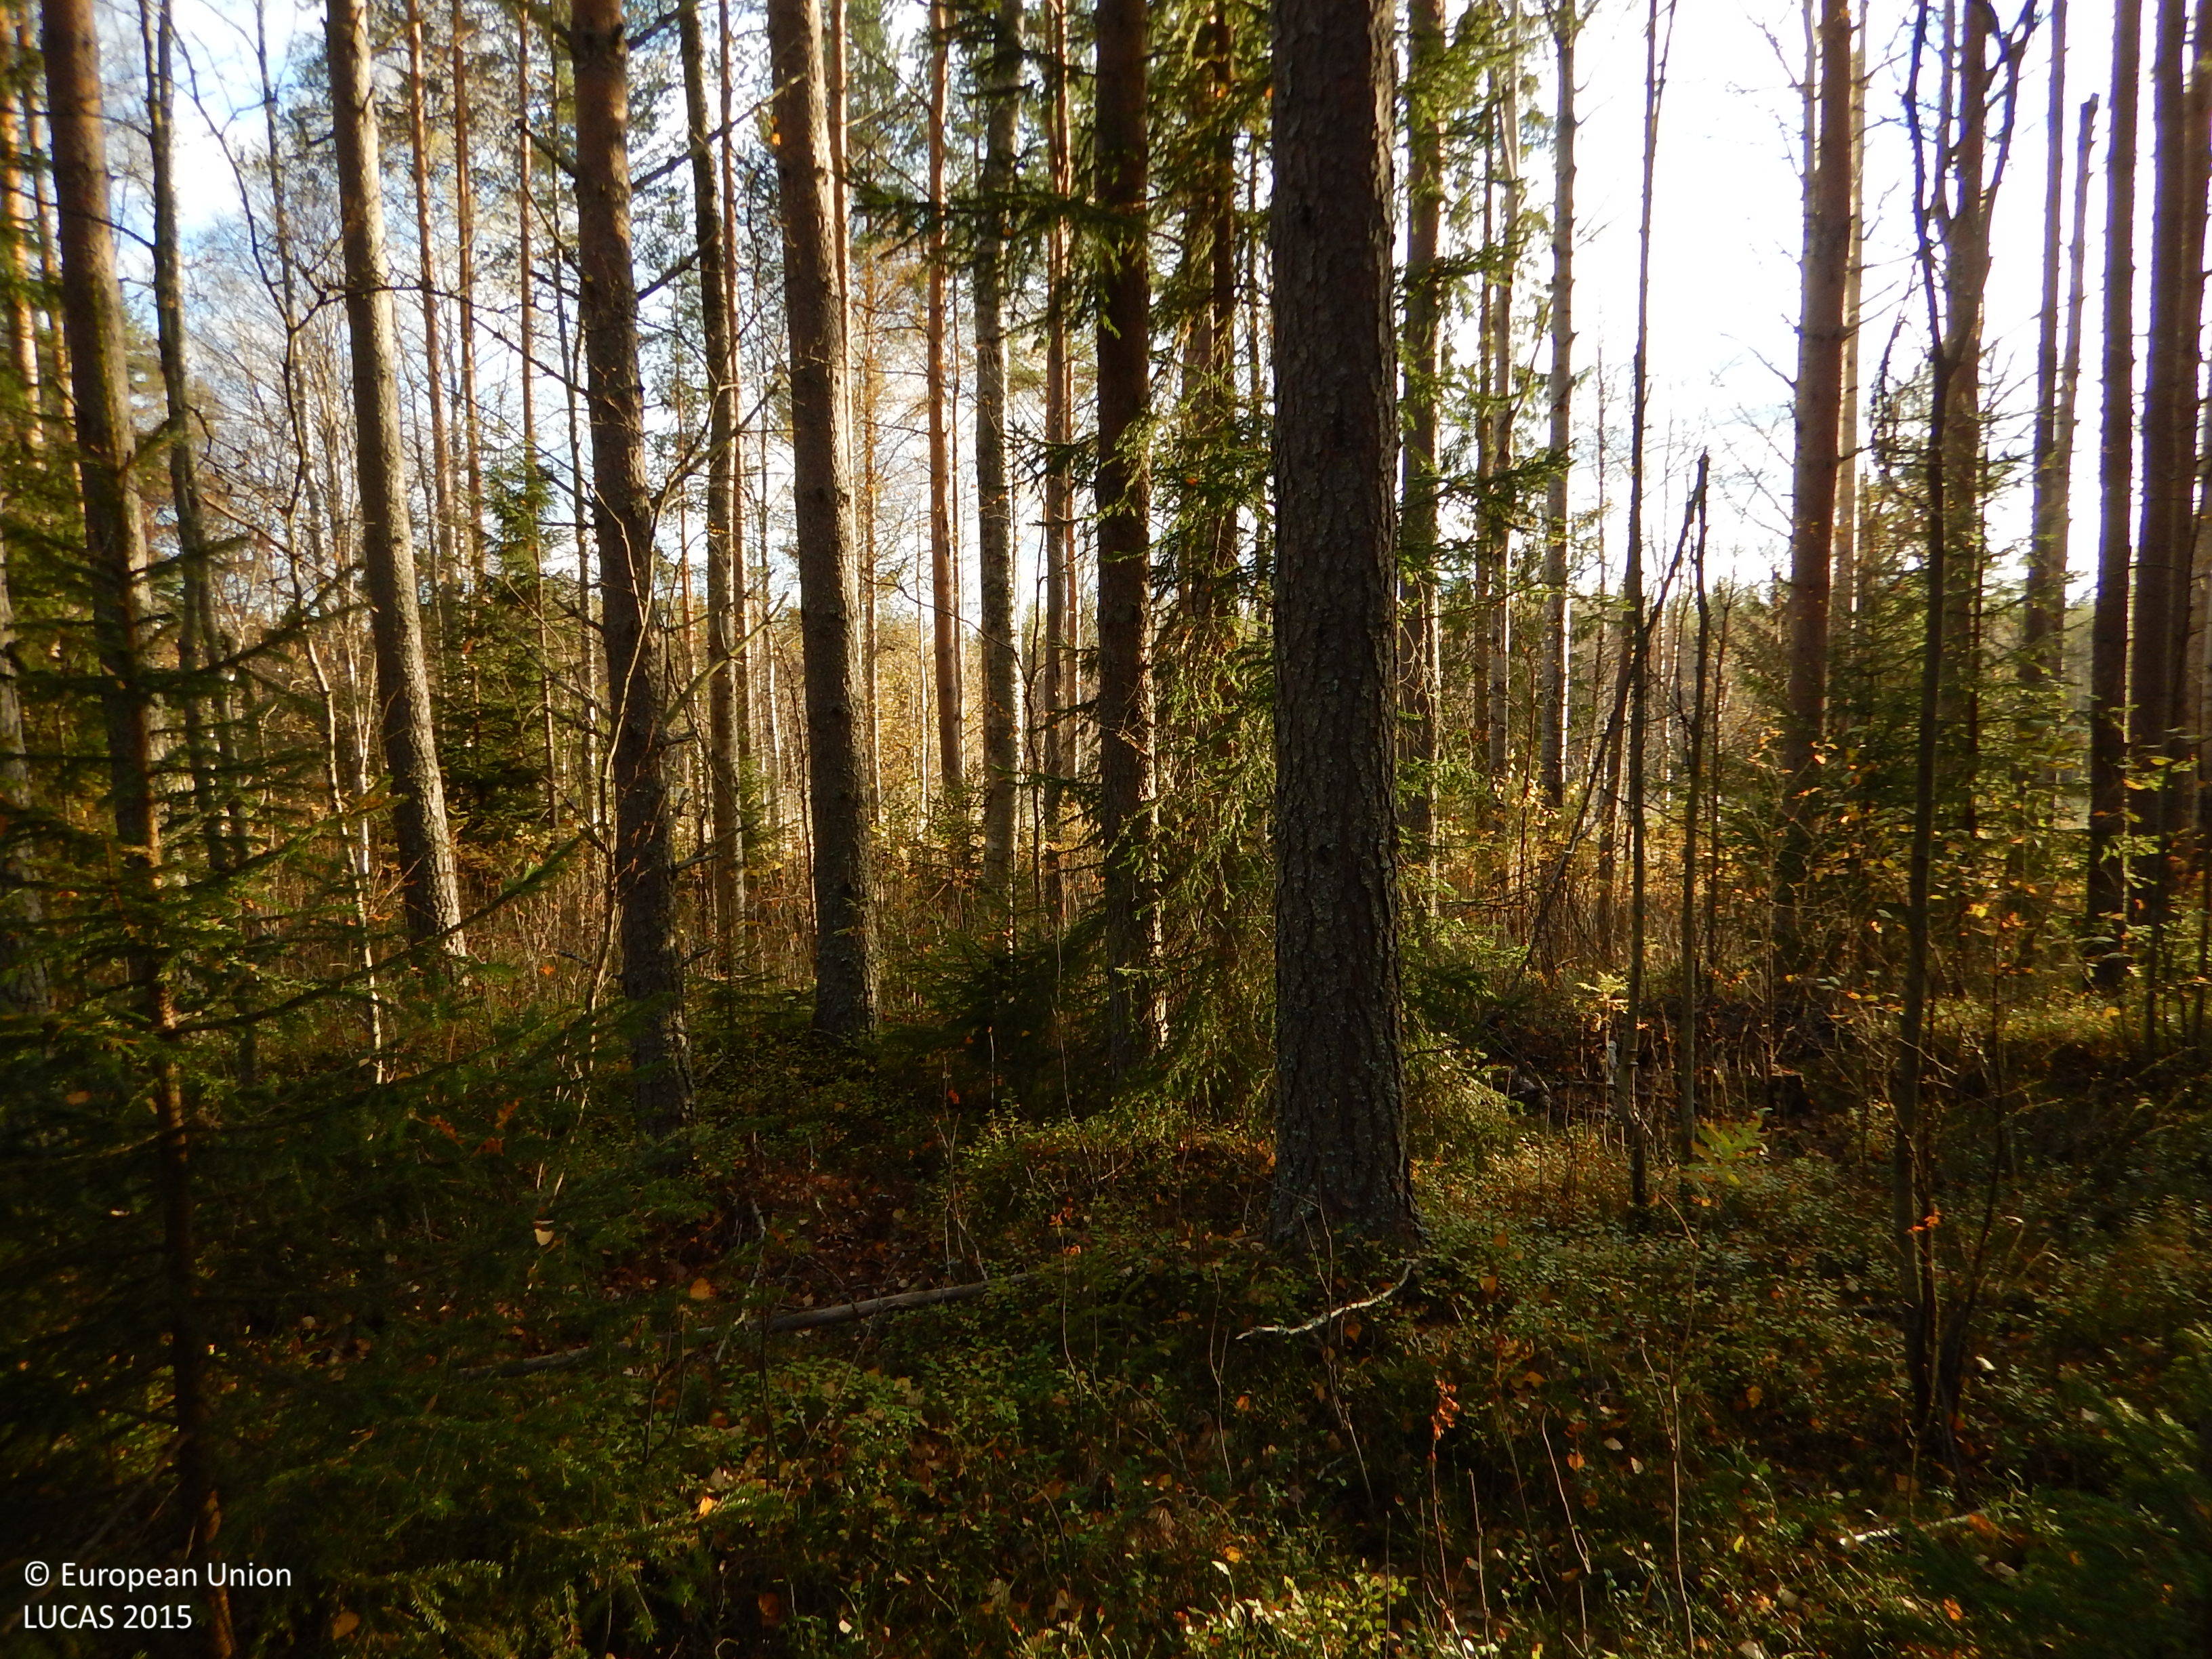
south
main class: Woodland
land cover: Pine dominated coniferous woodland
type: boreal forest
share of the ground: 50 - 75 %
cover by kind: coniferous forest trees 50 %, shrubs 20 %, herbaceous plants 15 %, broadleaved forest trees 10 %, lichens and mosses 5 %
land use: Residential
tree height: > 5 m
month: October
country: SE
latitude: 64.9260
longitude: 21.0373
